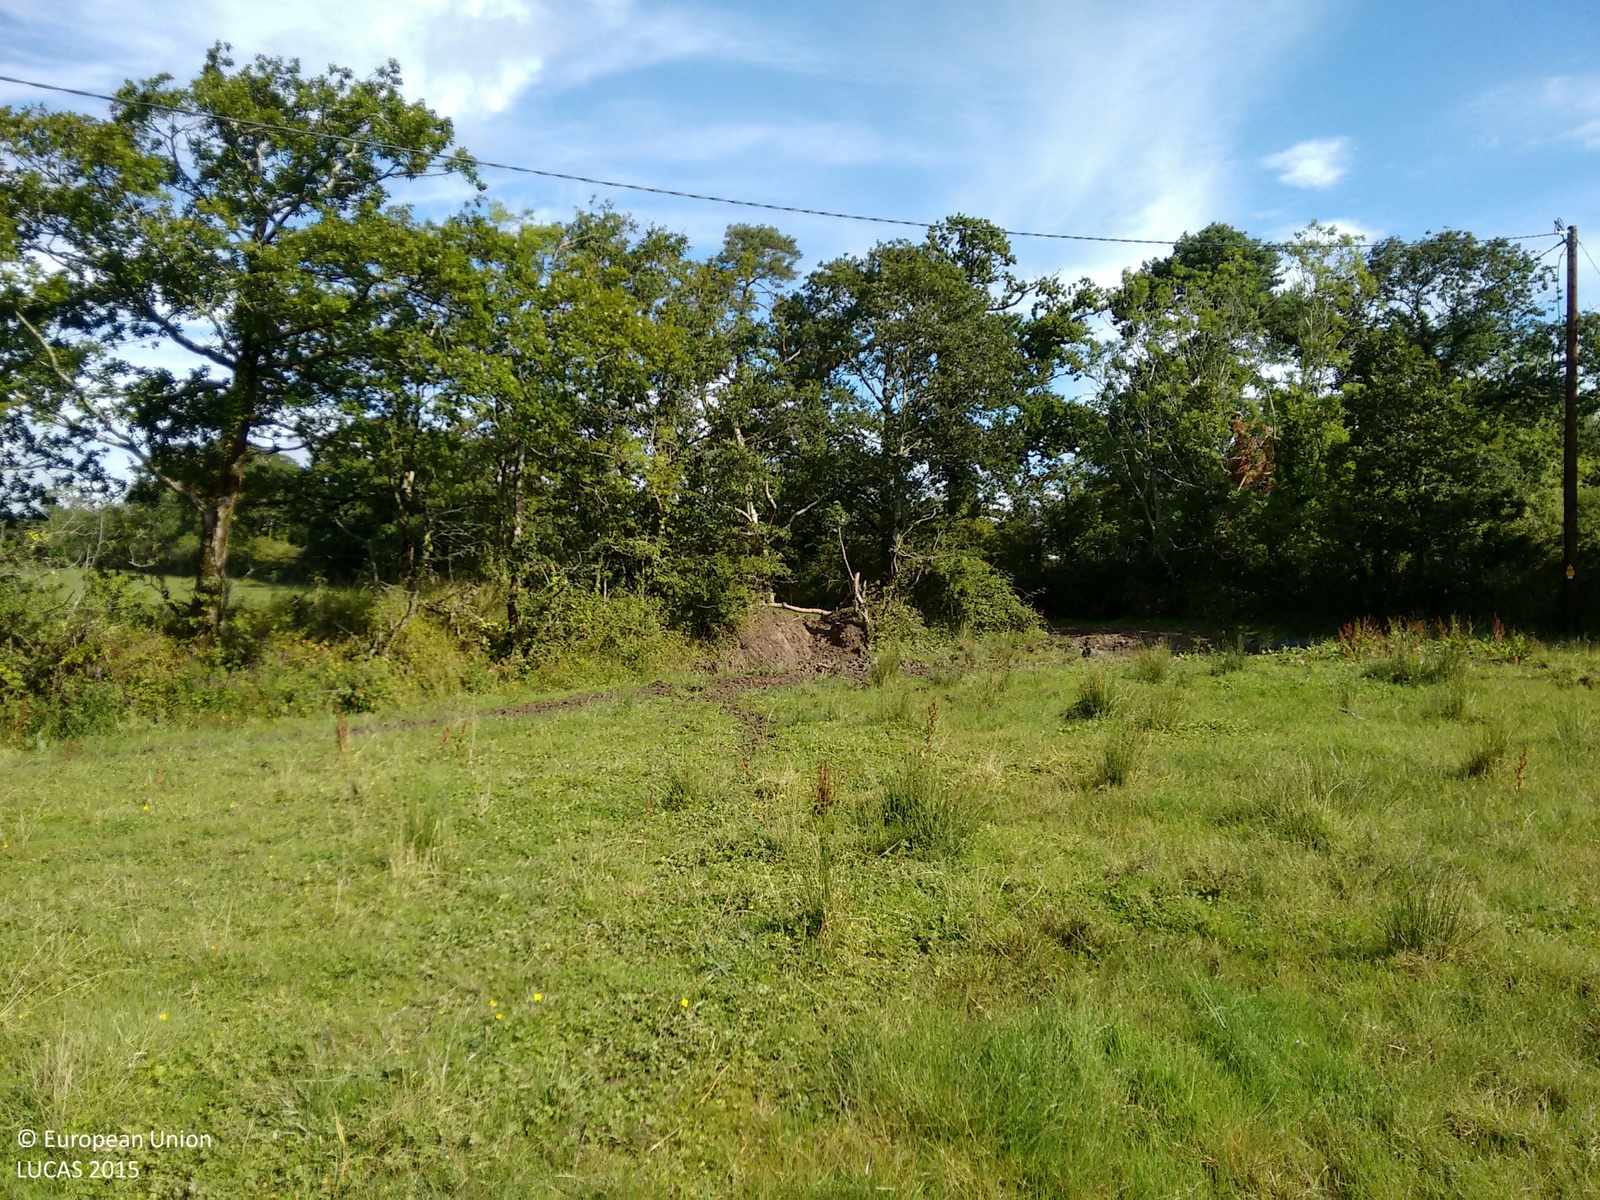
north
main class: Grassland
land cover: Grassland without tree/shrub cover
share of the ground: > 75 %
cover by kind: herbaceous plants 95 %, unconsolidated bare surface 5 %
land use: Agriculture (excluding fallow land and kitchen gardens)
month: August
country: IE
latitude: 52.7425
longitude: -6.1902
